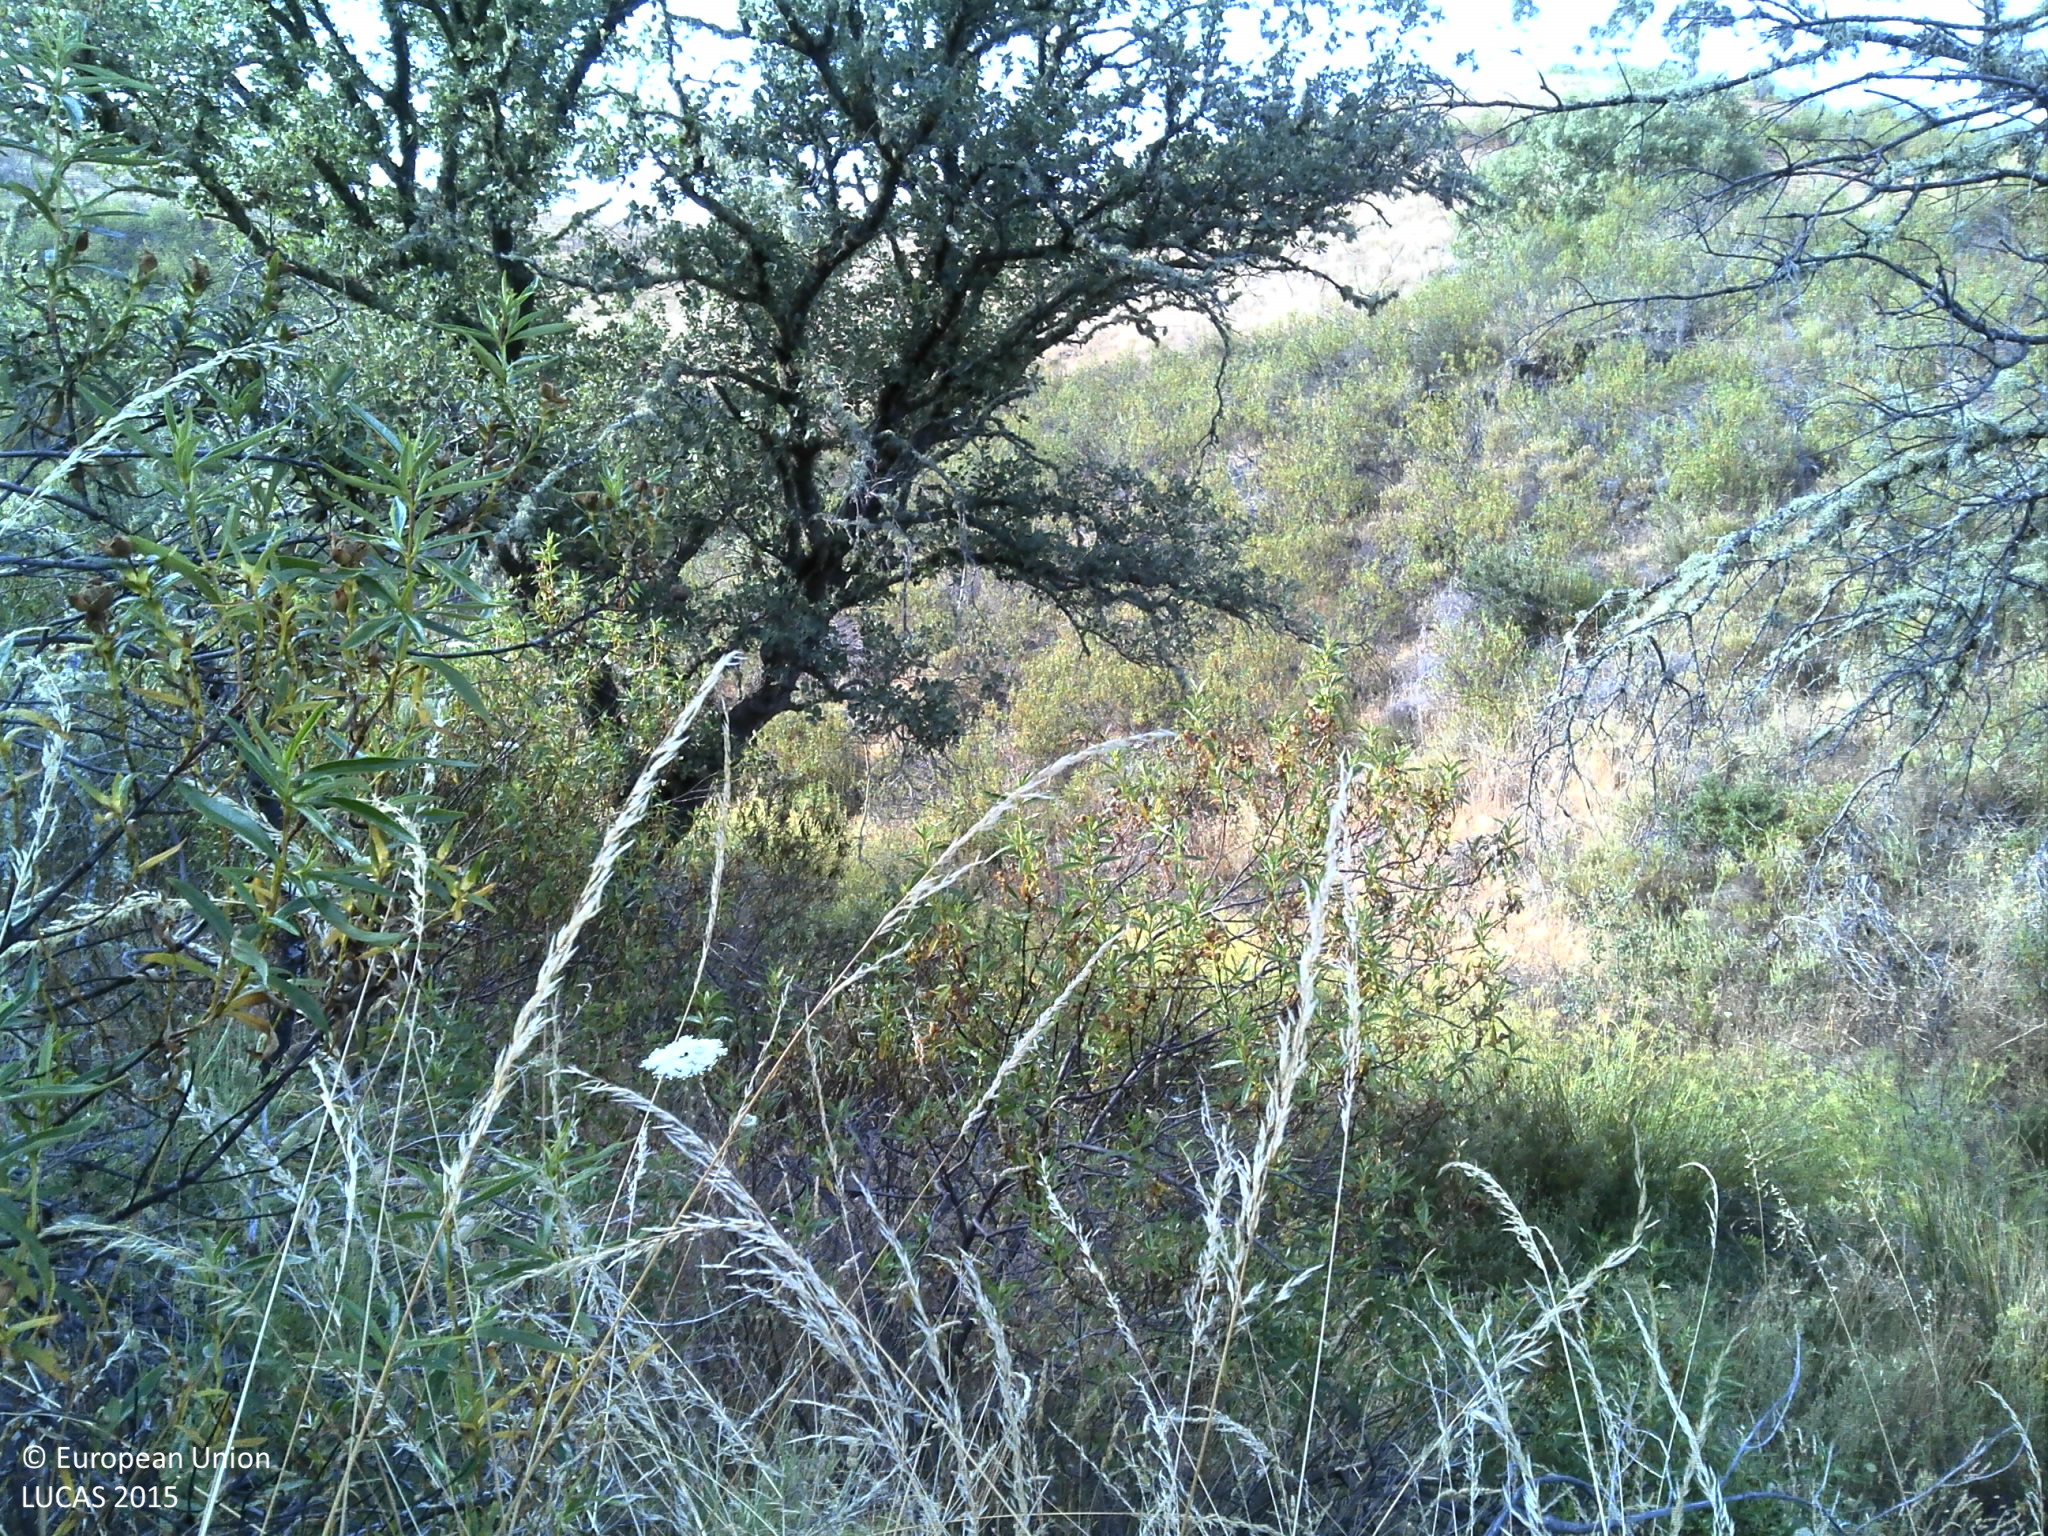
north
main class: Shrubland
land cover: Shrubland with sparse tree cover
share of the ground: > 75 %
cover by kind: shrubs 95 %, broadleaved forest trees 5 %
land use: Abandoned areas
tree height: < 5 m
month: June
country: PT
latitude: 37.7465
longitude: -7.4566
